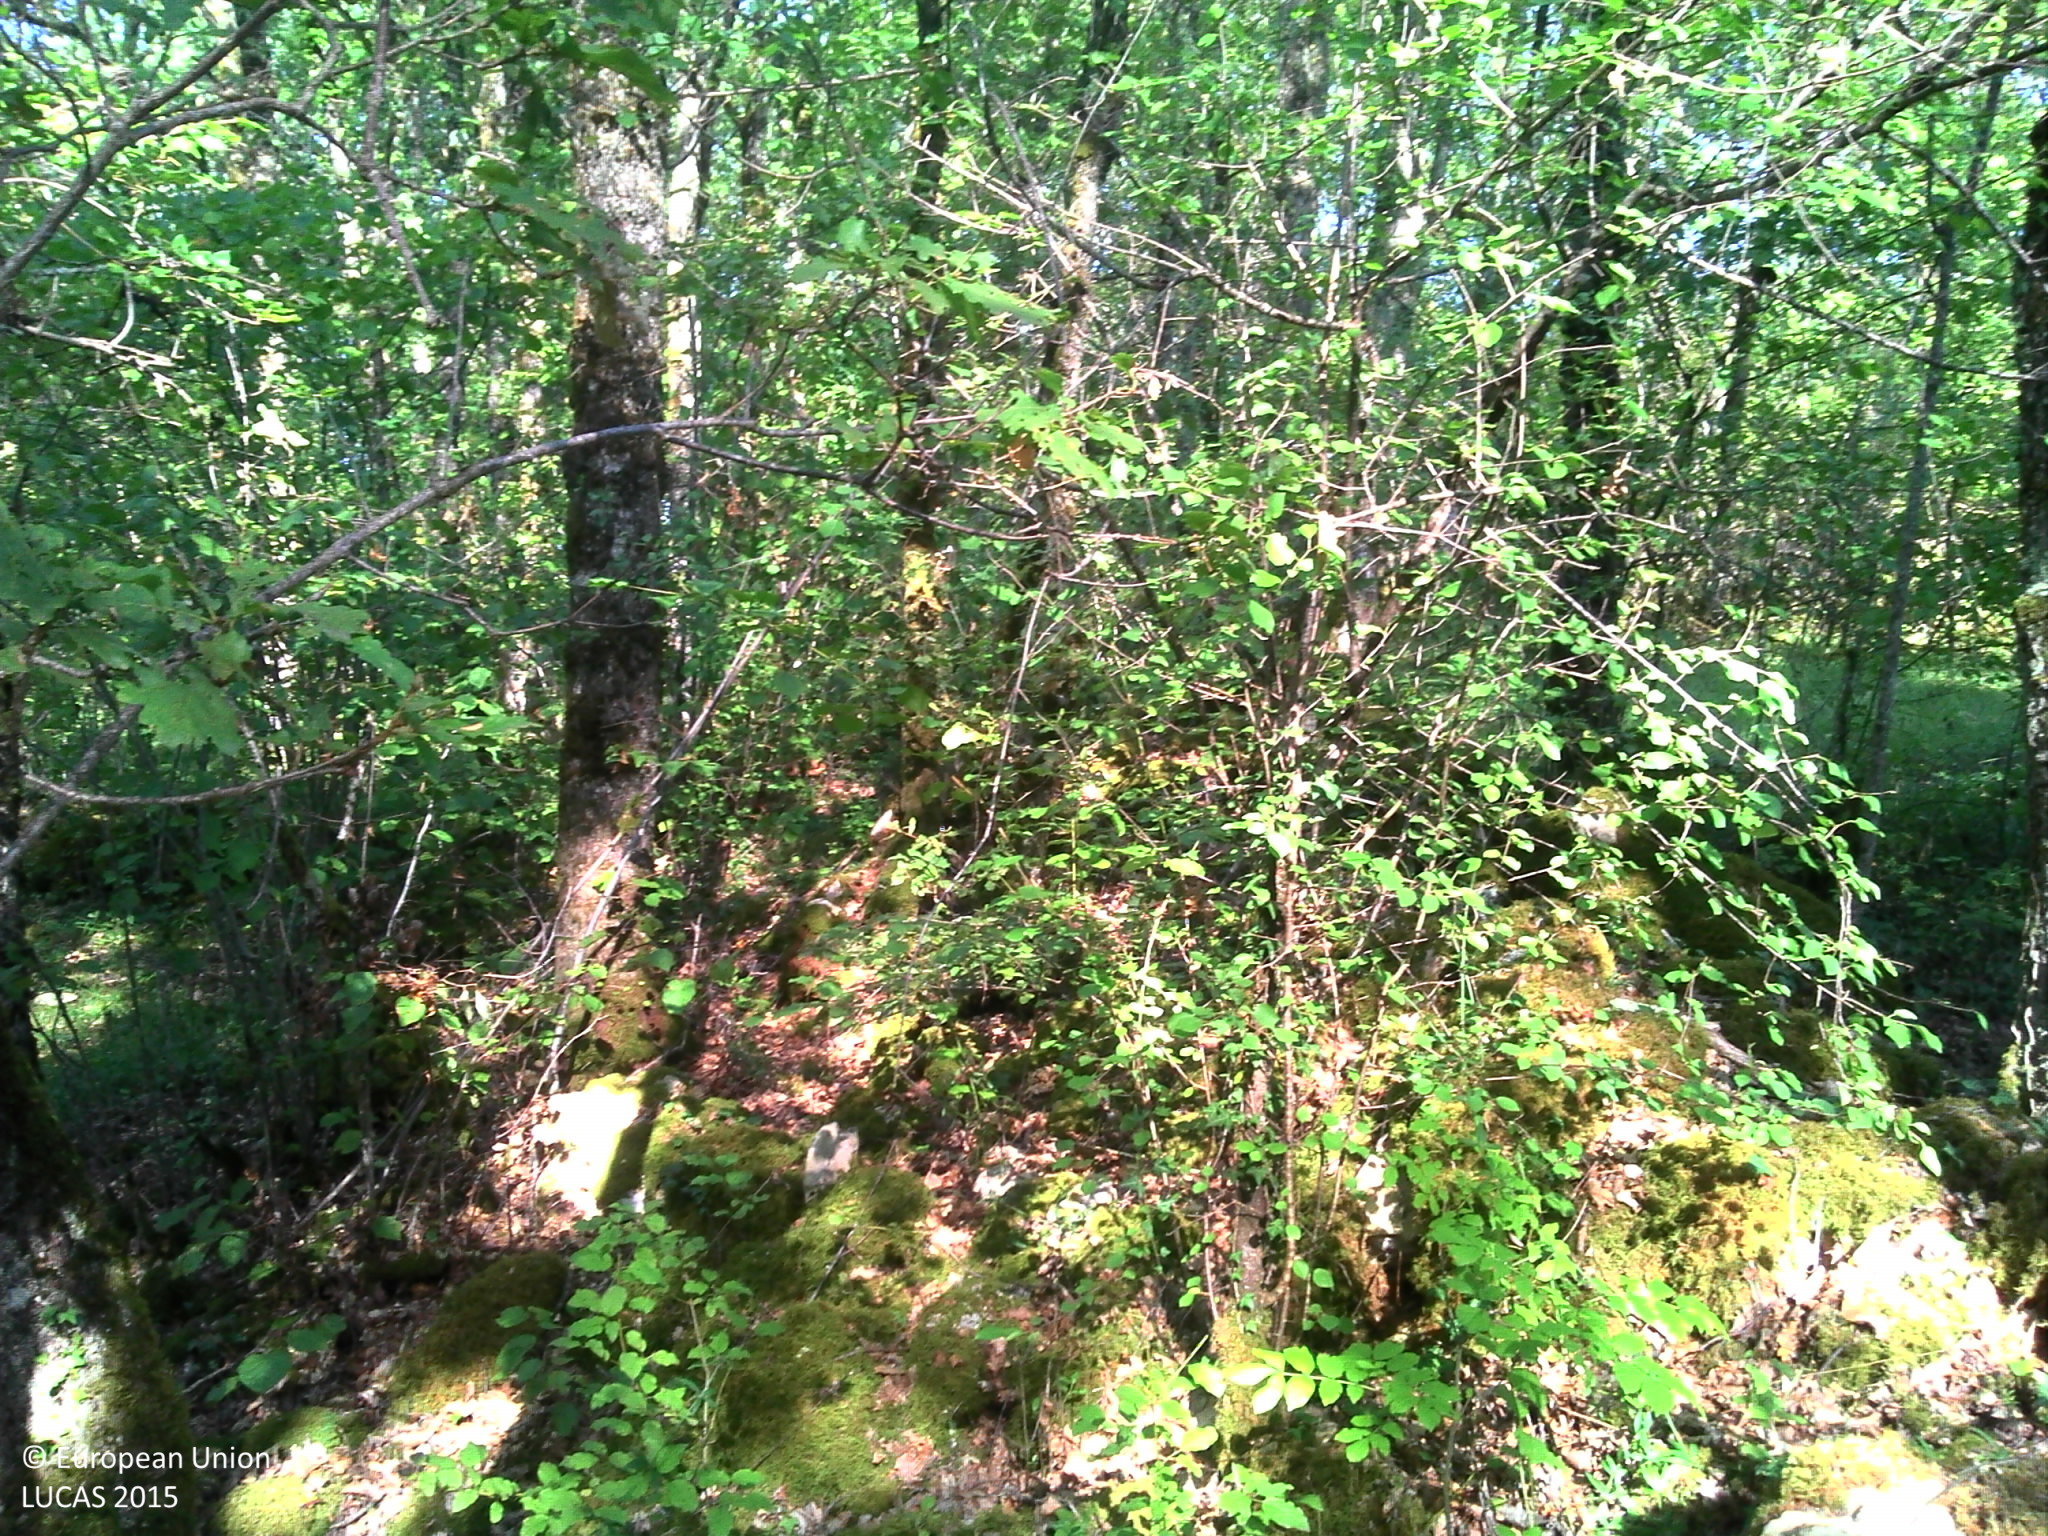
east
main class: Woodland
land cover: Broadleaved woodland
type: mesophytic deciduous forest
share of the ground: > 75 %
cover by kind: broadleaved forest trees 80 %, shrubs 10 %, herbaceous plants 5 %, lichens and mosses 5 %
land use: Forestry
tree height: > 5 m
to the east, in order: Dry stone walls; Broadleaved woodland; Dry stone walls; Fences; Broadleaved woodland; Grassland without tree/shrub cover; Shrubland with sparse tree cover; Grassland without tree/shrub cover; Electric lines; Grassland without tree/shrub cover
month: August
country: FR
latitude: 44.6497
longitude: 1.2326
